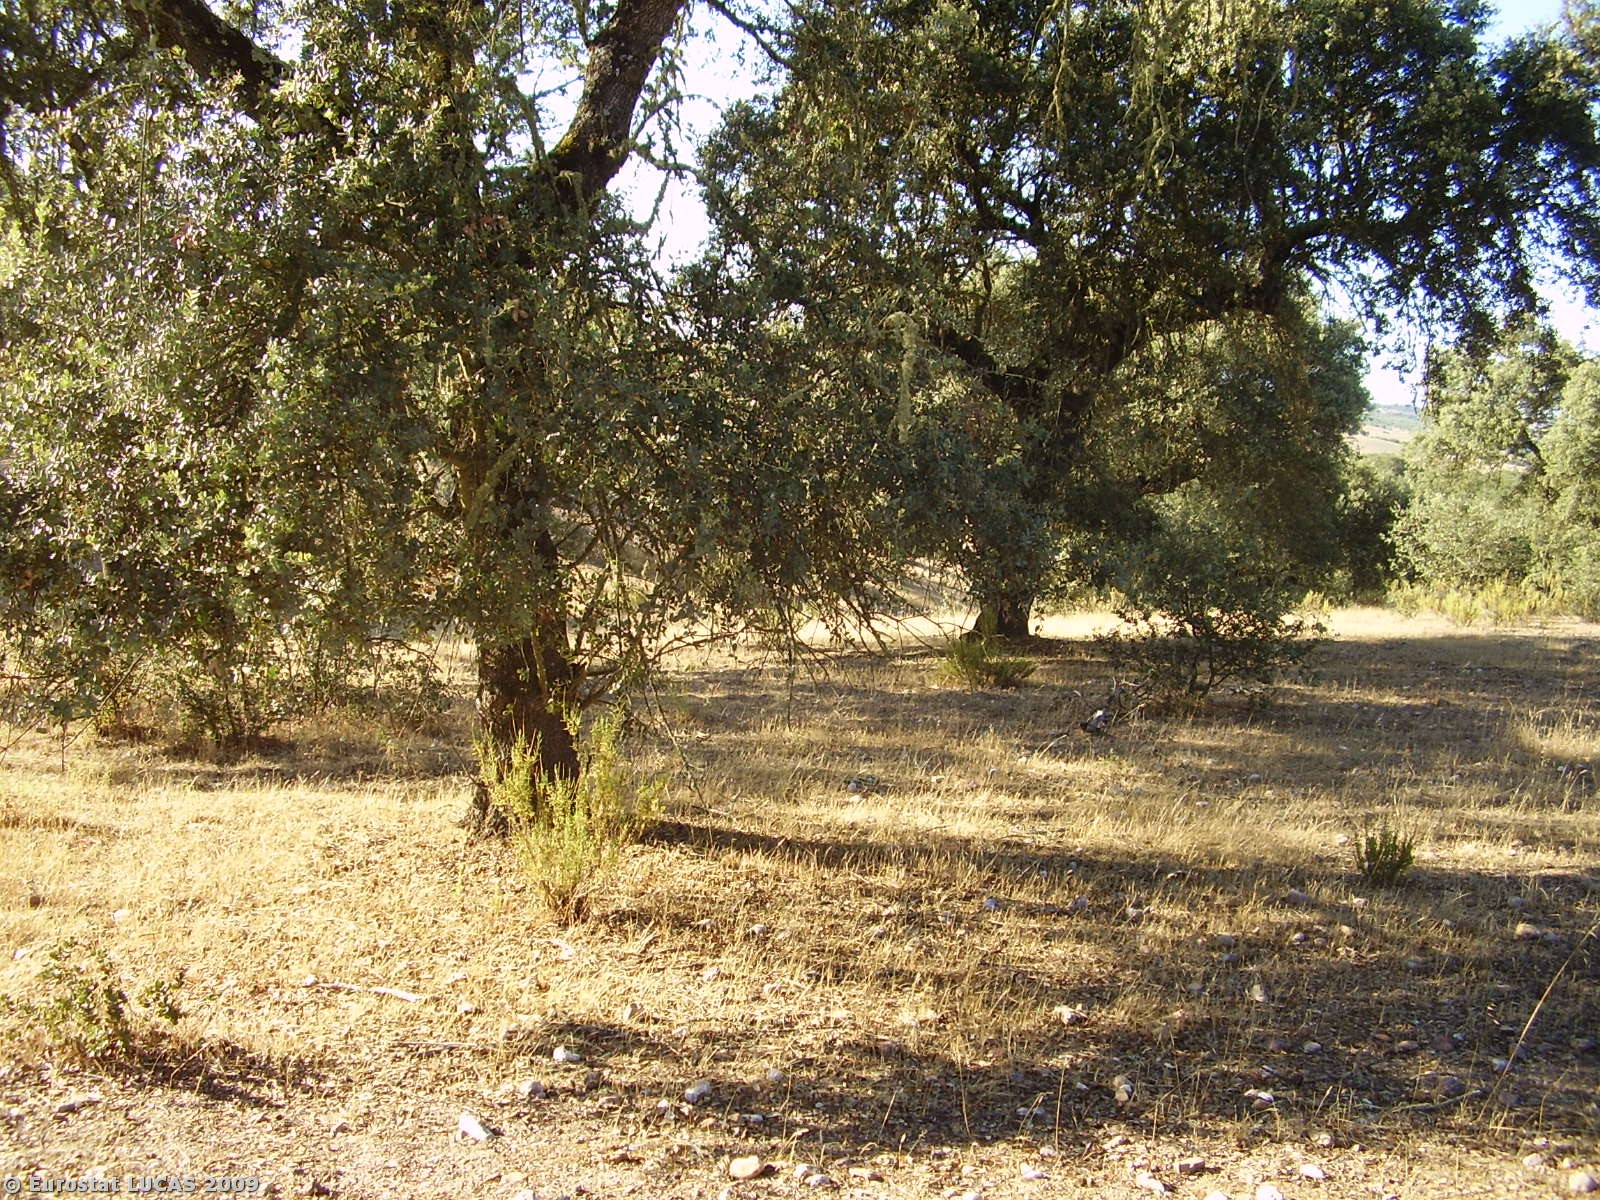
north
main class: Woodland
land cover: Broadleaved woodland
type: broadleaved evergreen forest
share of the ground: 25 - 50 %
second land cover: Spontaneously vegetated surfaces
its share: 10 - 25 %
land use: Forestry
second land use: Fallow land
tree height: > 5 m
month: July
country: PT
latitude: 38.9318
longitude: -8.0335
